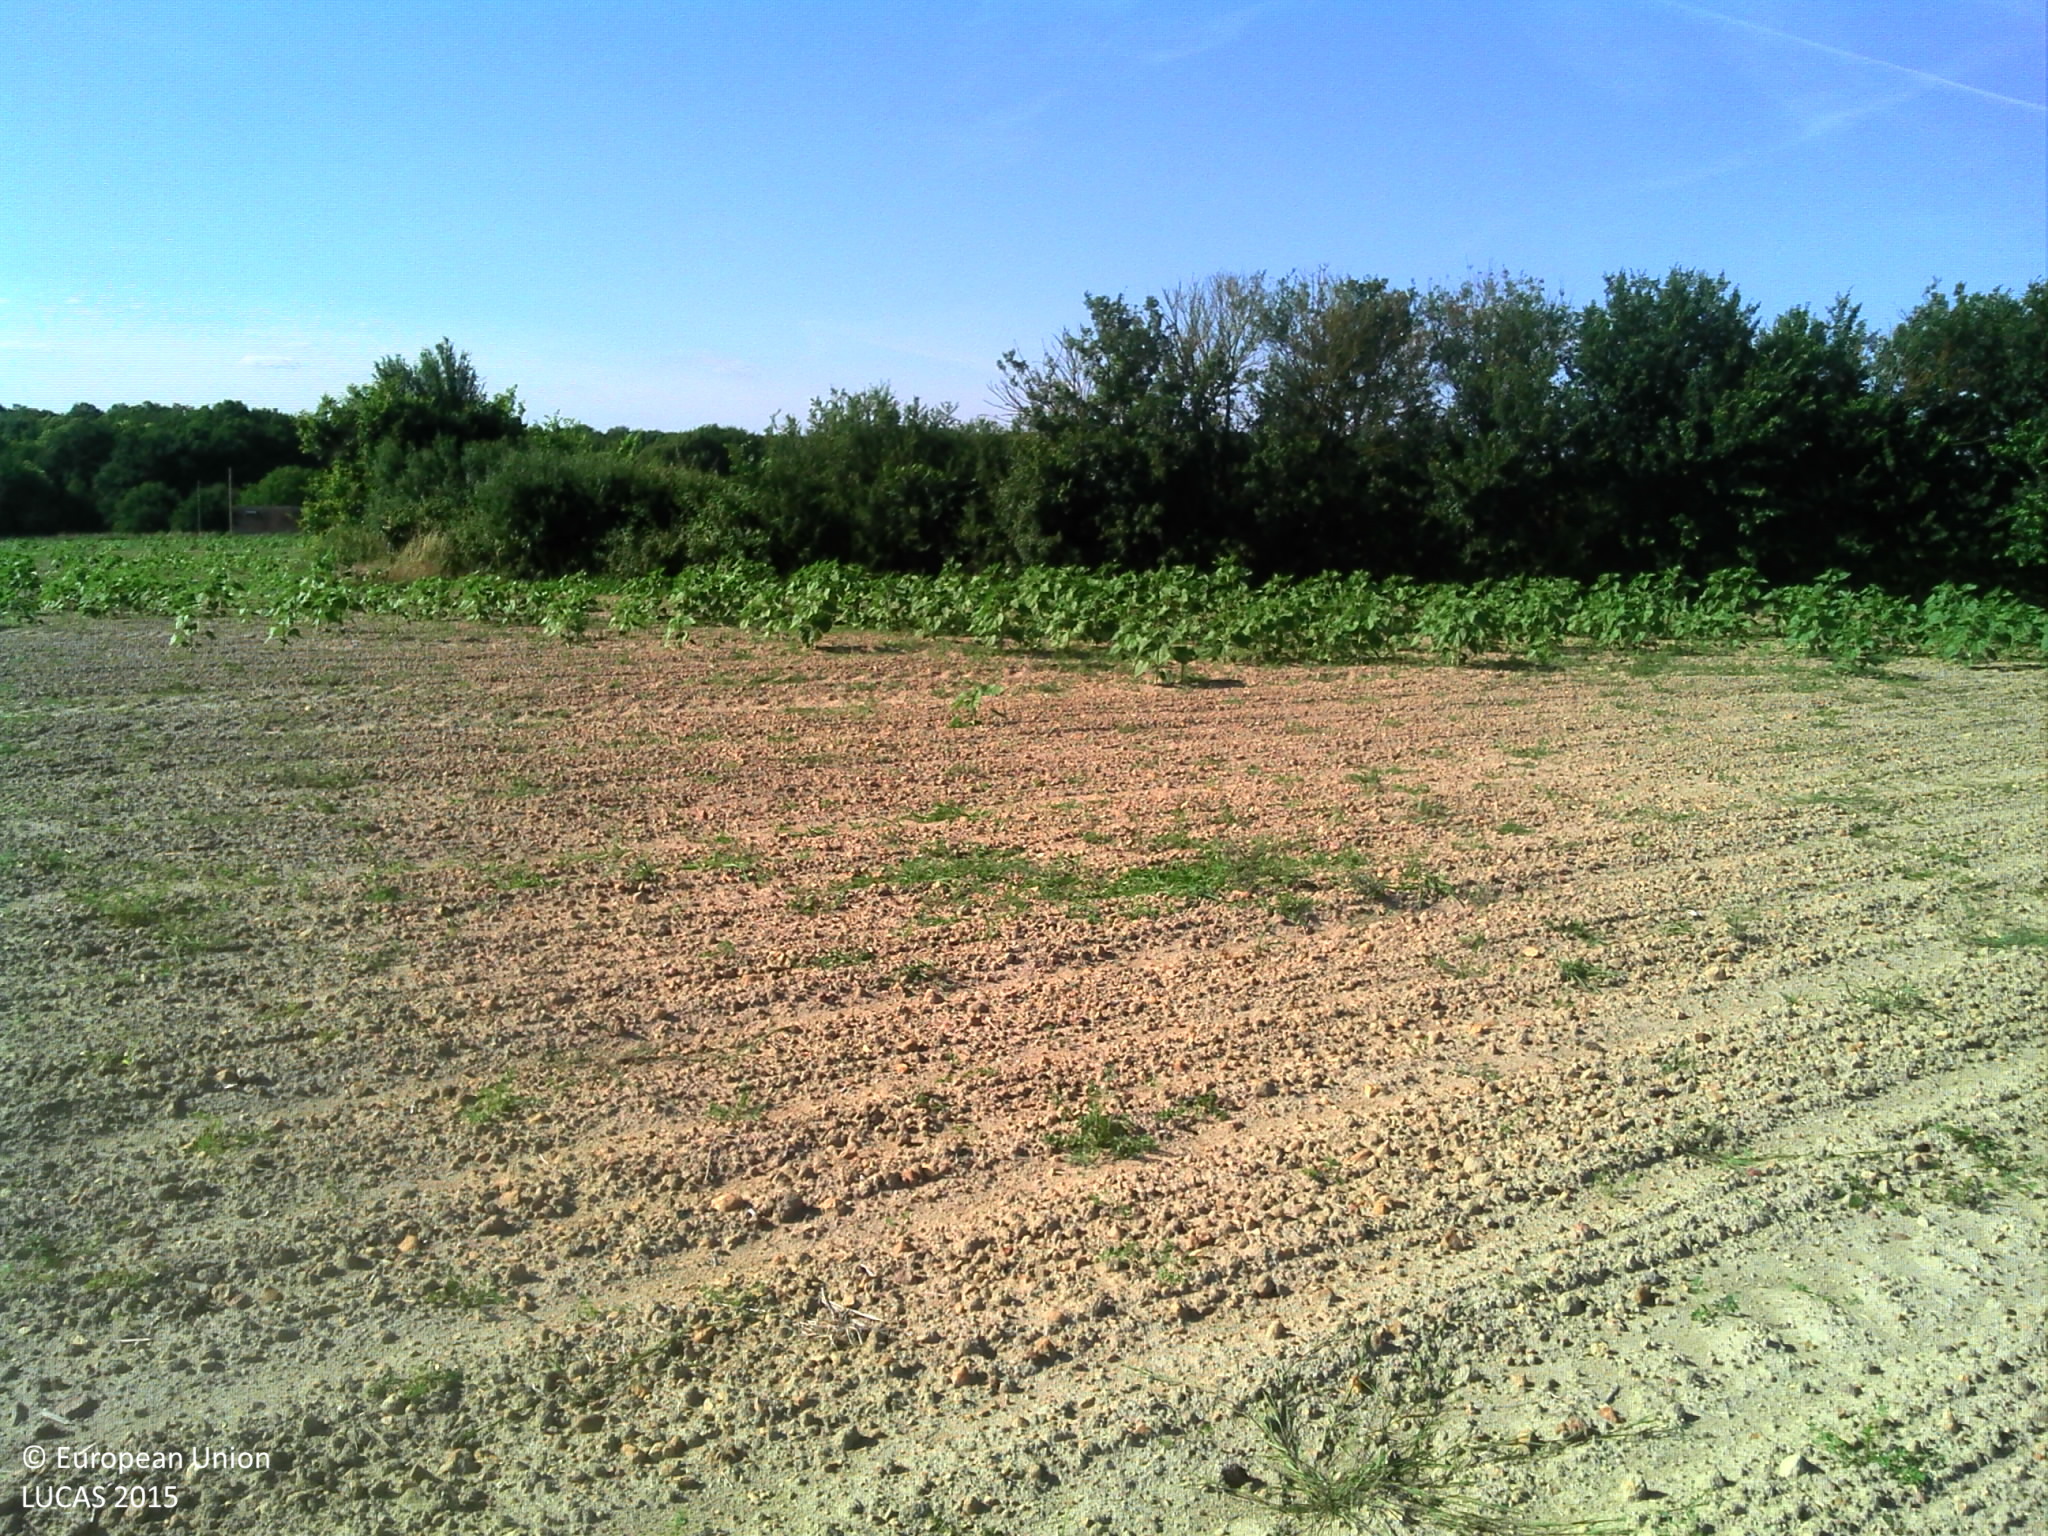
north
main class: Cropland
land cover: Sunflower
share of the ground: 10 - 25 %
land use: Agriculture (excluding fallow land and kitchen gardens)
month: June
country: FR
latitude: 47.5558
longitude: 0.2618
